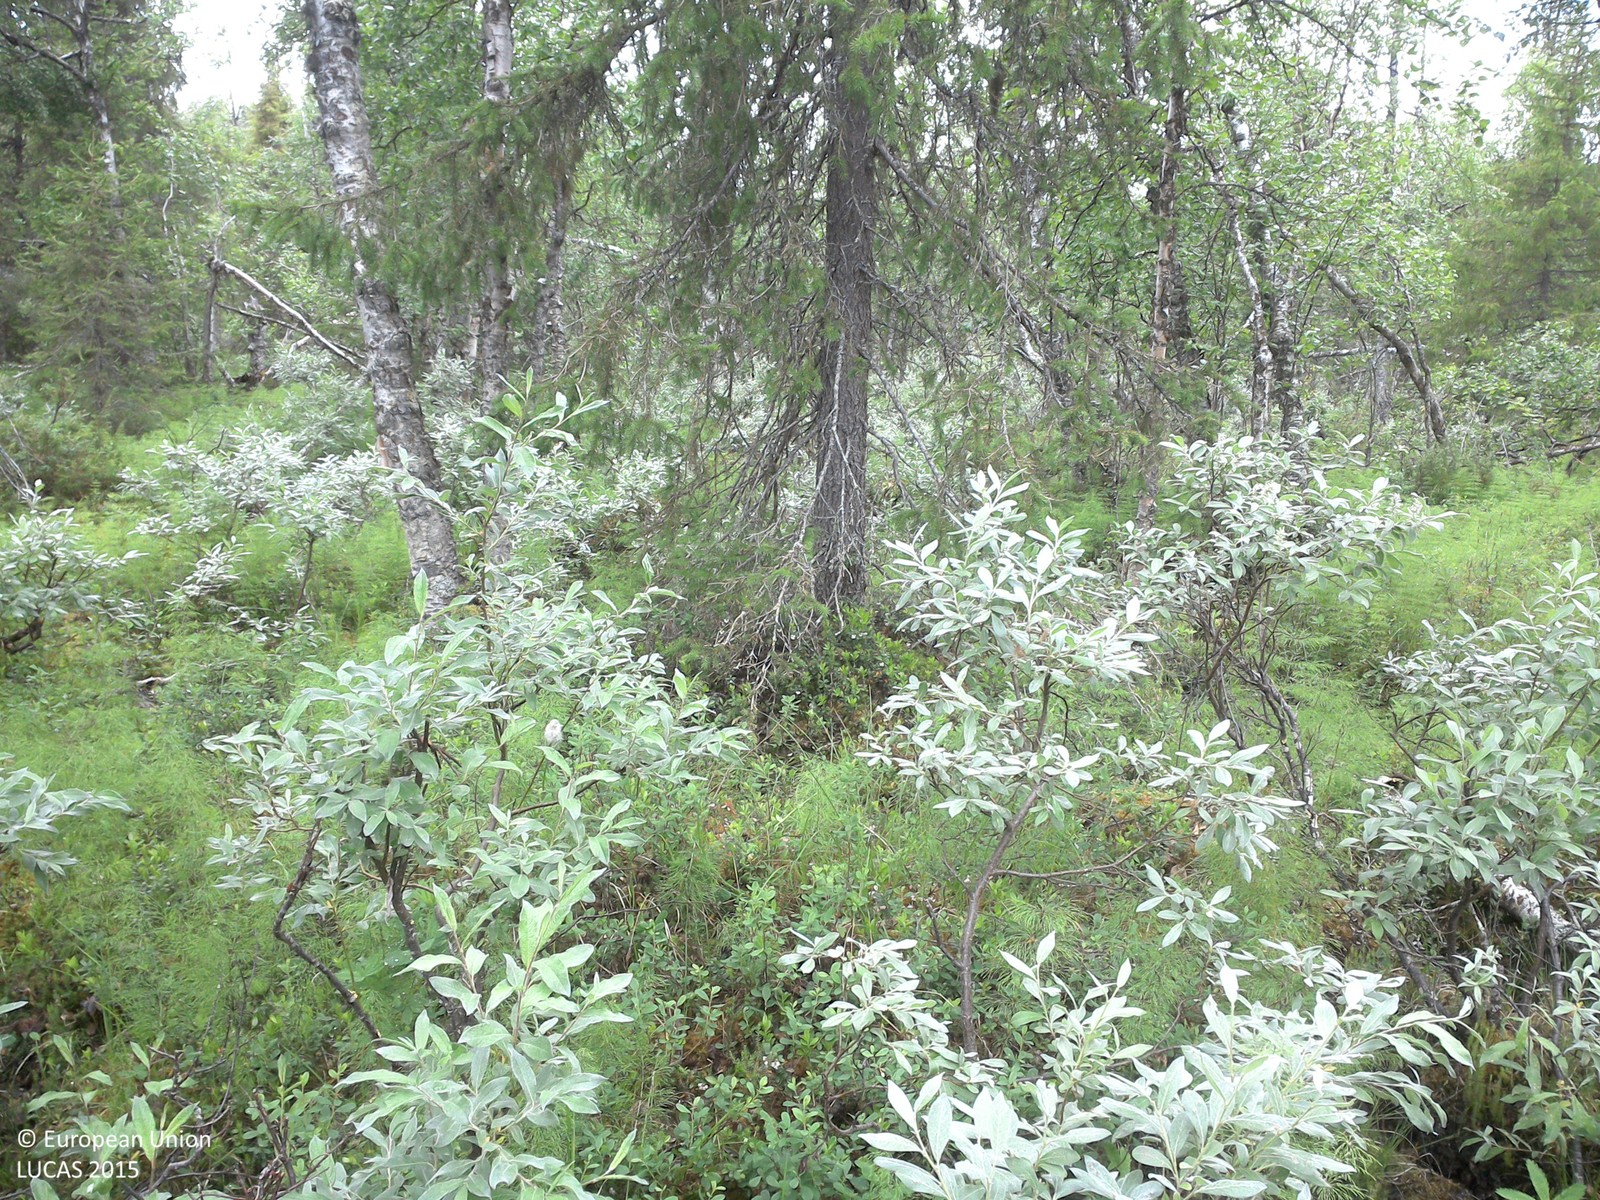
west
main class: Woodland
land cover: Spruce dominated mixed woodland
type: boreal forest
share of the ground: 25 - 50 %
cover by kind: shrubs 35 %, herbaceous plants 25 %, coniferous forest trees 20 %, broadleaved forest trees 15 %, lichens and mosses 5 %
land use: Forestry
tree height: > 5 m
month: July
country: SE
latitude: 67.7530
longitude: 23.0965
